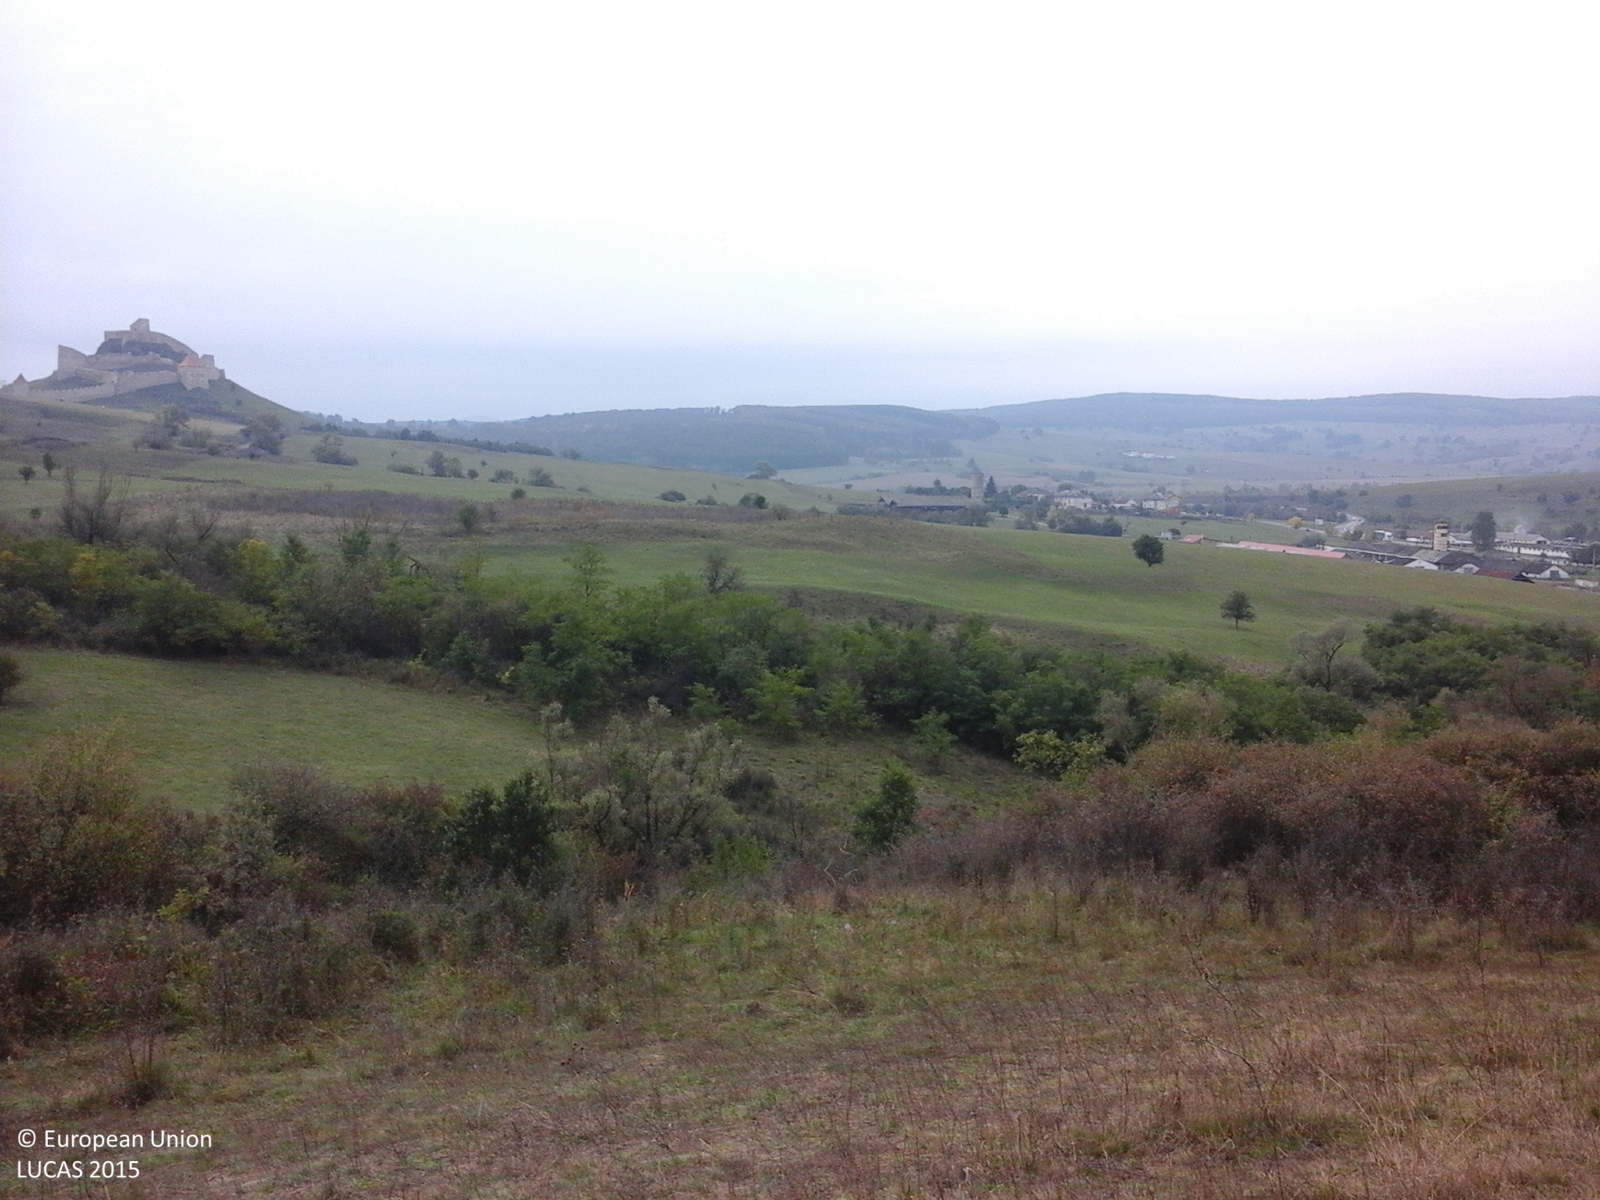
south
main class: Grassland
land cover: Spontaneously vegetated surfaces
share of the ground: > 75 %
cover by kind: herbaceous plants 100 %
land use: Fallow land
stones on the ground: < 10 %
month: October
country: RO
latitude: 46.0438
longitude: 25.2051
